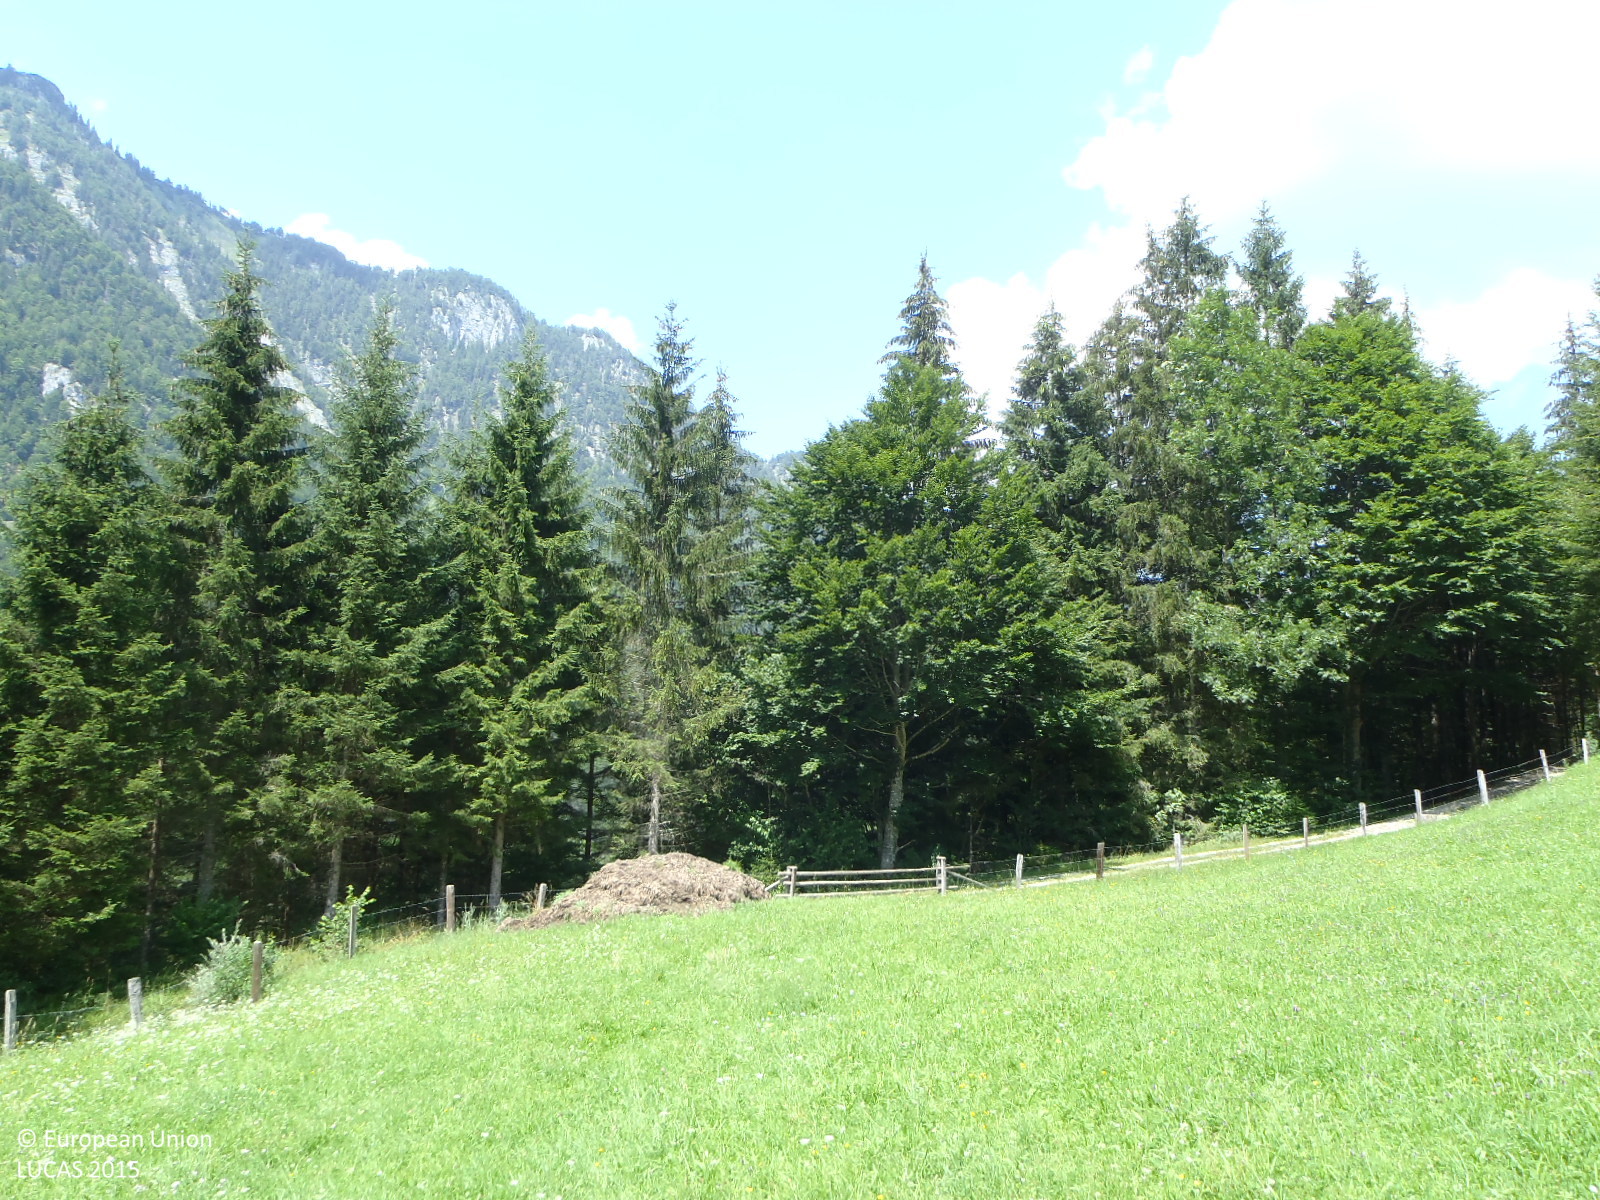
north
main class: Grassland
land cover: Grassland without tree/shrub cover
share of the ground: > 75 %
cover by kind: herbaceous plants 100 %
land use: Agriculture (excluding fallow land and kitchen gardens)
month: July
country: AT
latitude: 47.5231
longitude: 11.8978
